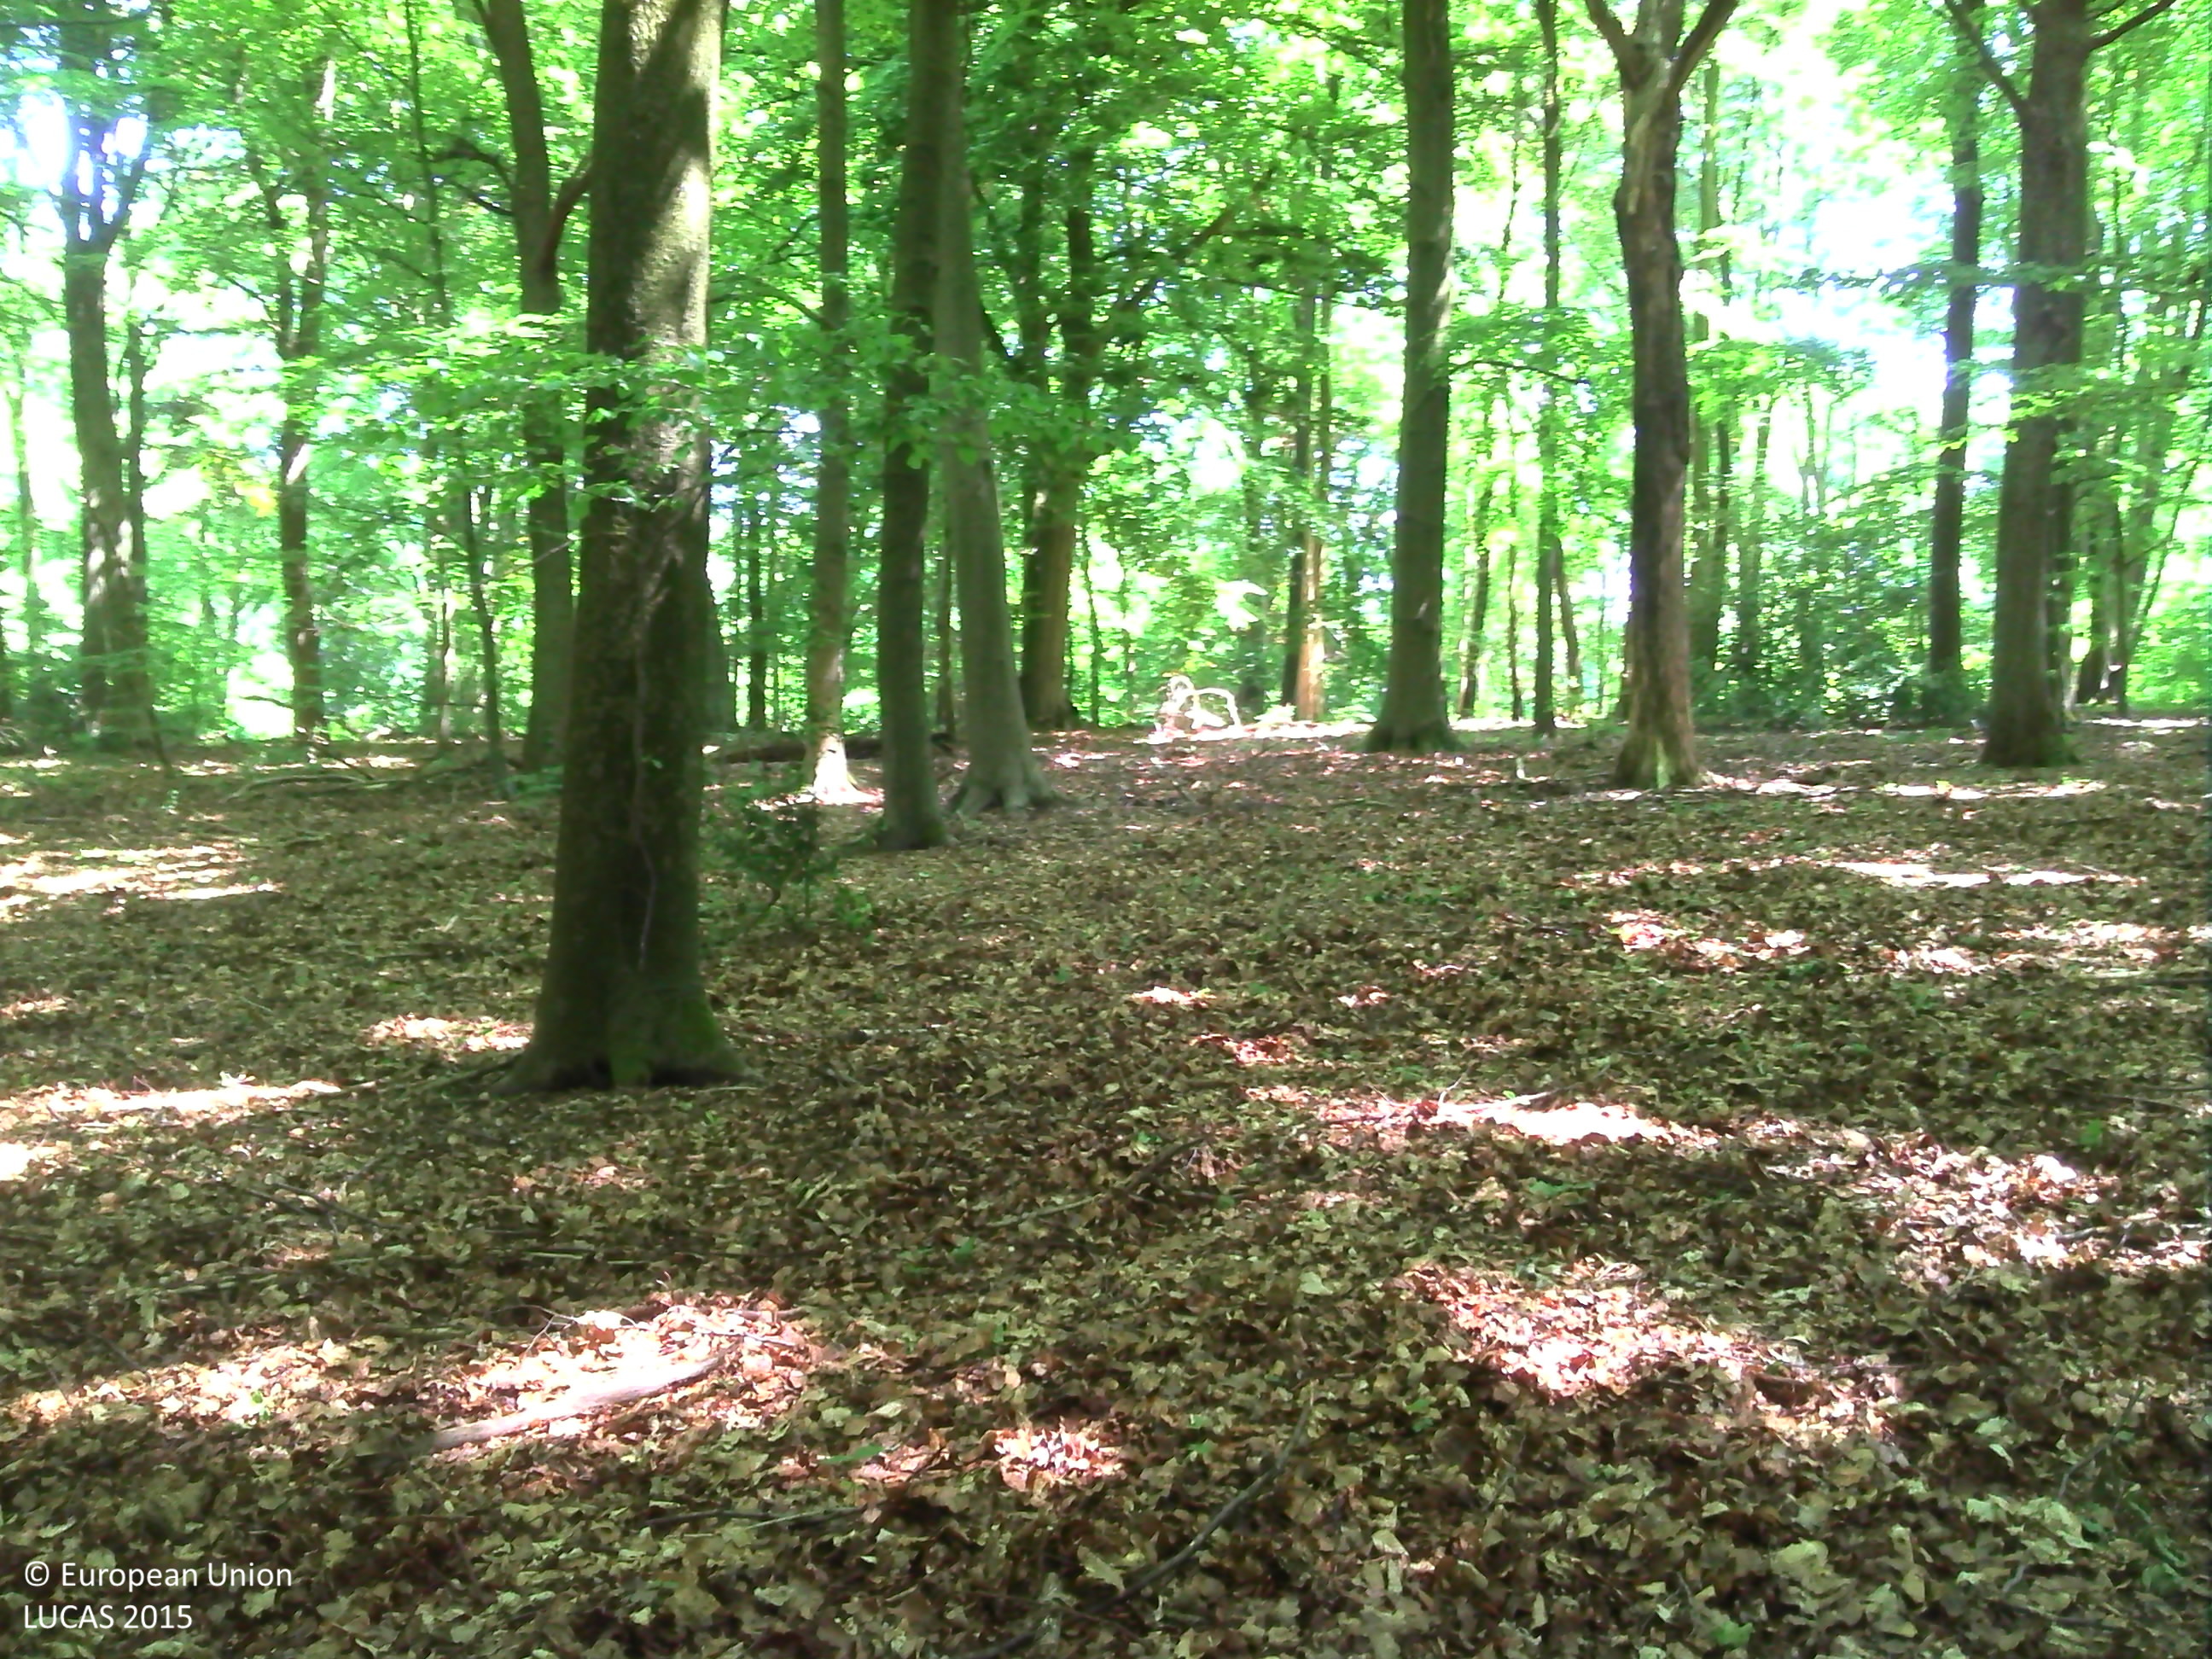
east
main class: Woodland
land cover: Broadleaved woodland
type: acidophilous oak and oak-birch forest
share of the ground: > 75 %
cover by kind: broadleaved forest trees 95 %, herbaceous plants 5 %
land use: Forestry
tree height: > 5 m
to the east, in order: Broadleaved woodland; Ditches and canals; Broadleaved woodland; Grass margins; Paved roads, cycling and walking lanes; Grass margins; Broadleaved woodland; Spontaneously vegetated surfaces; Rivers and streams; Artificial constructions in urban areas
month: June
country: BE
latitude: 50.5646
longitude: 5.5229
